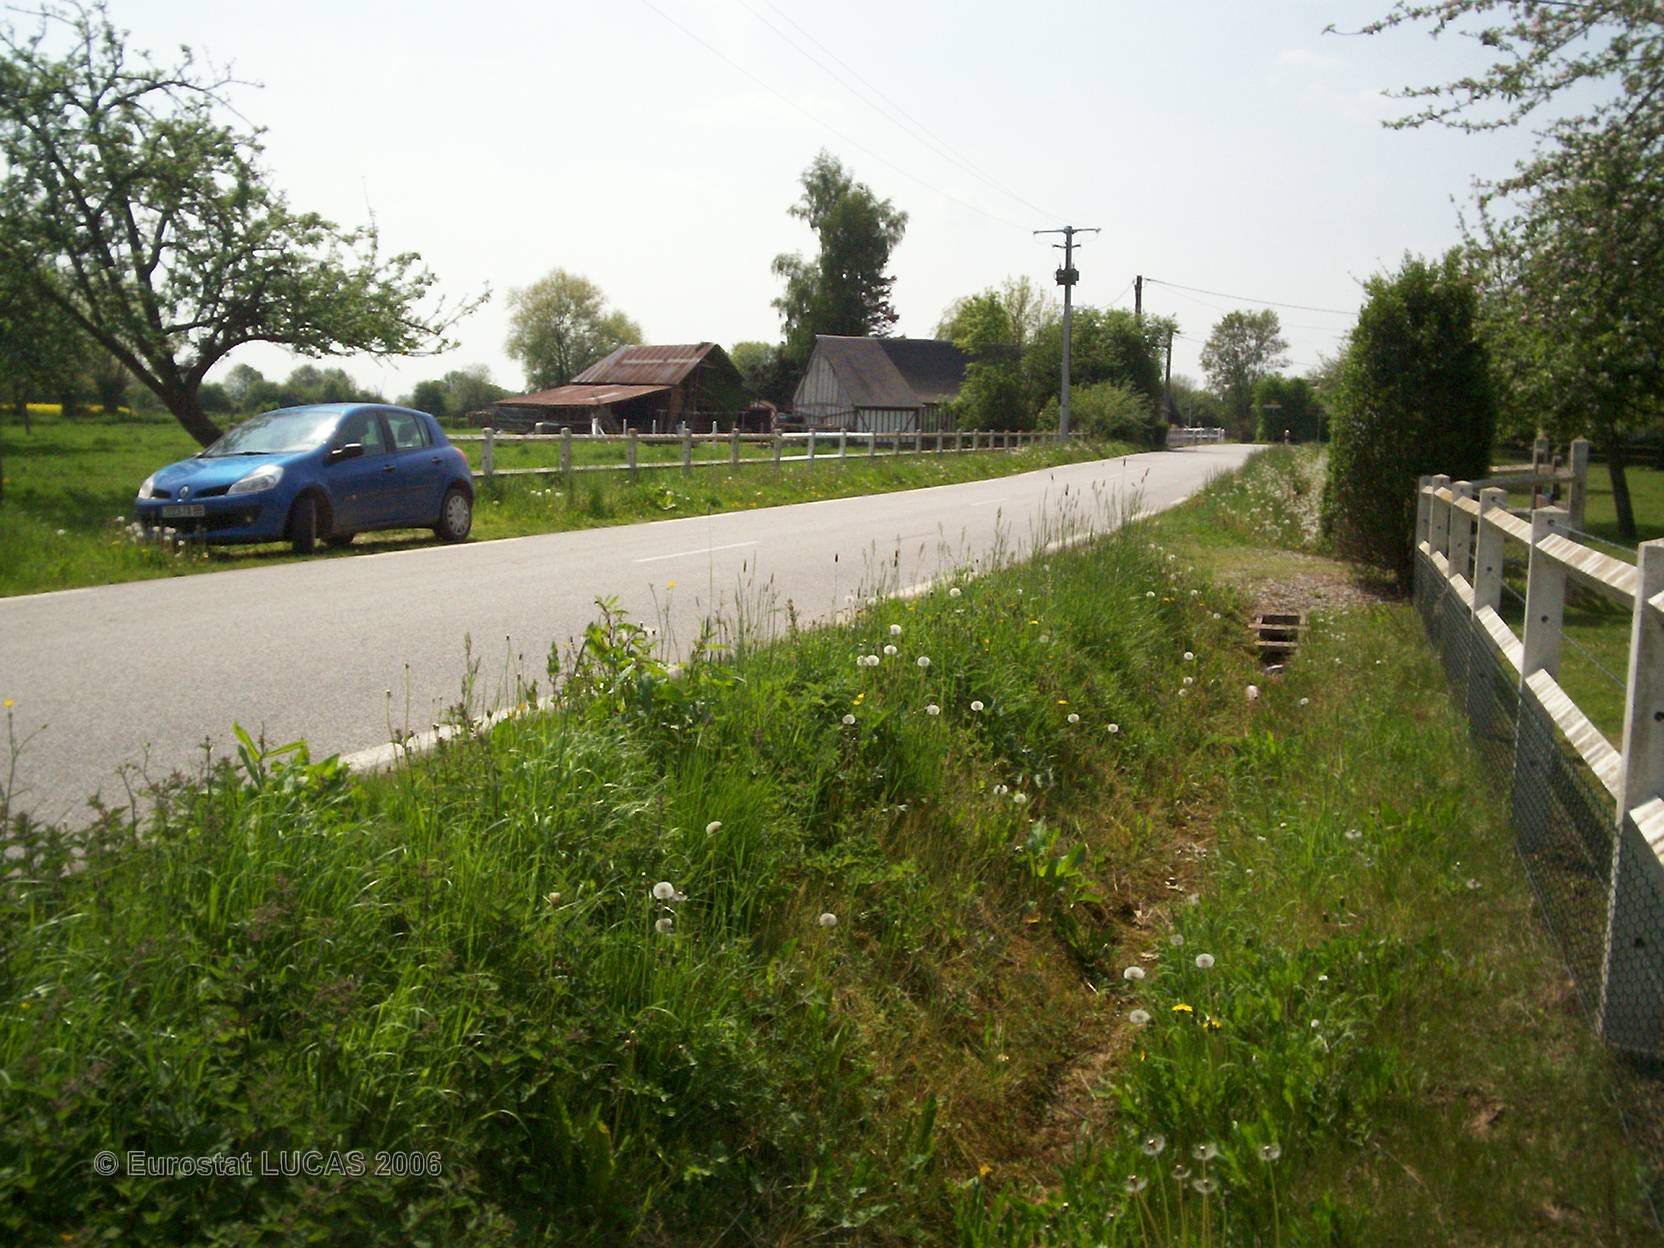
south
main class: Grassland
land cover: Grassland with sparse tree/shrub cover
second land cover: Apple fruit
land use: Agriculture (excluding fallow land and kitchen gardens)
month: May
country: FR
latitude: 49.2063
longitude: 0.4891
